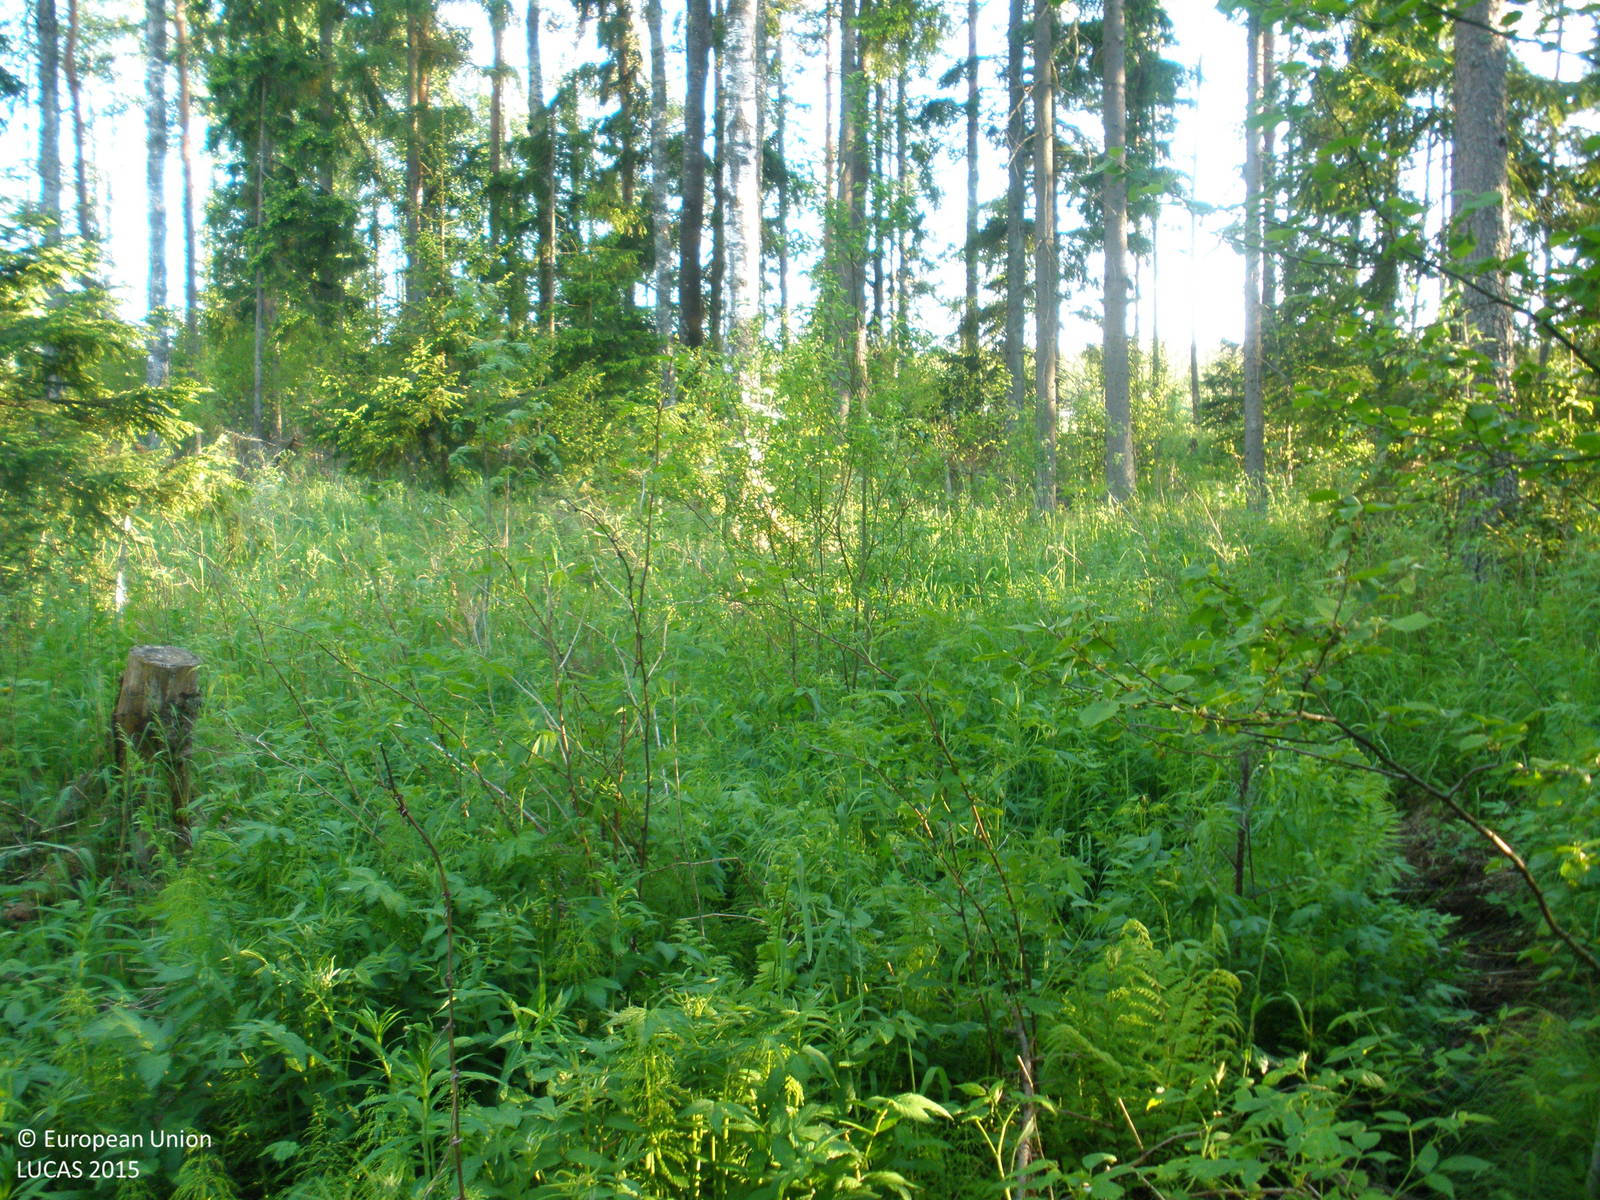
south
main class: Woodland
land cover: Spruce dominated mixed woodland
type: boreal forest
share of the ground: 50 - 75 %
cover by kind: coniferous forest trees 45 %, broadleaved forest trees 25 %, herbaceous plants 15 %, shrubs 10 %, lichens and mosses 5 %
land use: Forestry
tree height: > 5 m
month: June
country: FI
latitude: 60.8886
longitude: 23.6297
